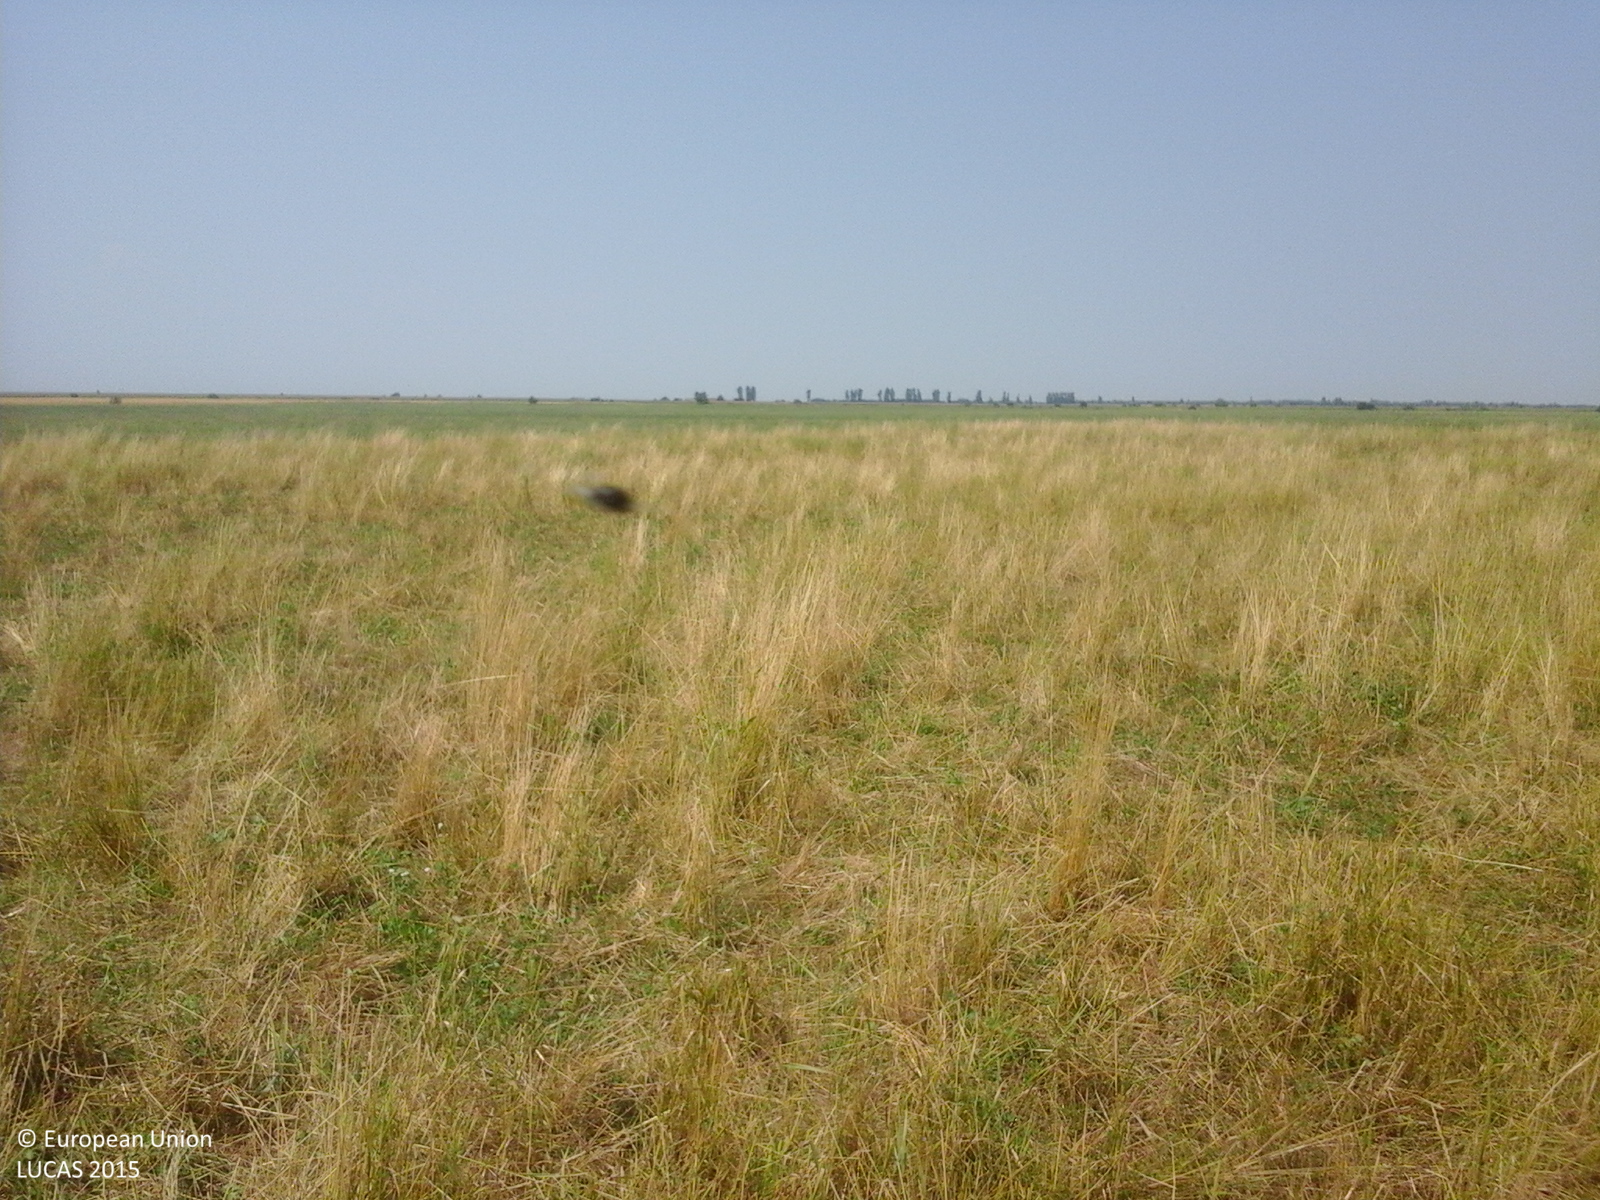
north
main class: Grassland
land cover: Grassland without tree/shrub cover
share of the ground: > 75 %
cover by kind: herbaceous plants 100 %
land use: Agriculture (excluding fallow land and kitchen gardens)
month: July
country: RO
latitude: 44.8424
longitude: 26.8144
